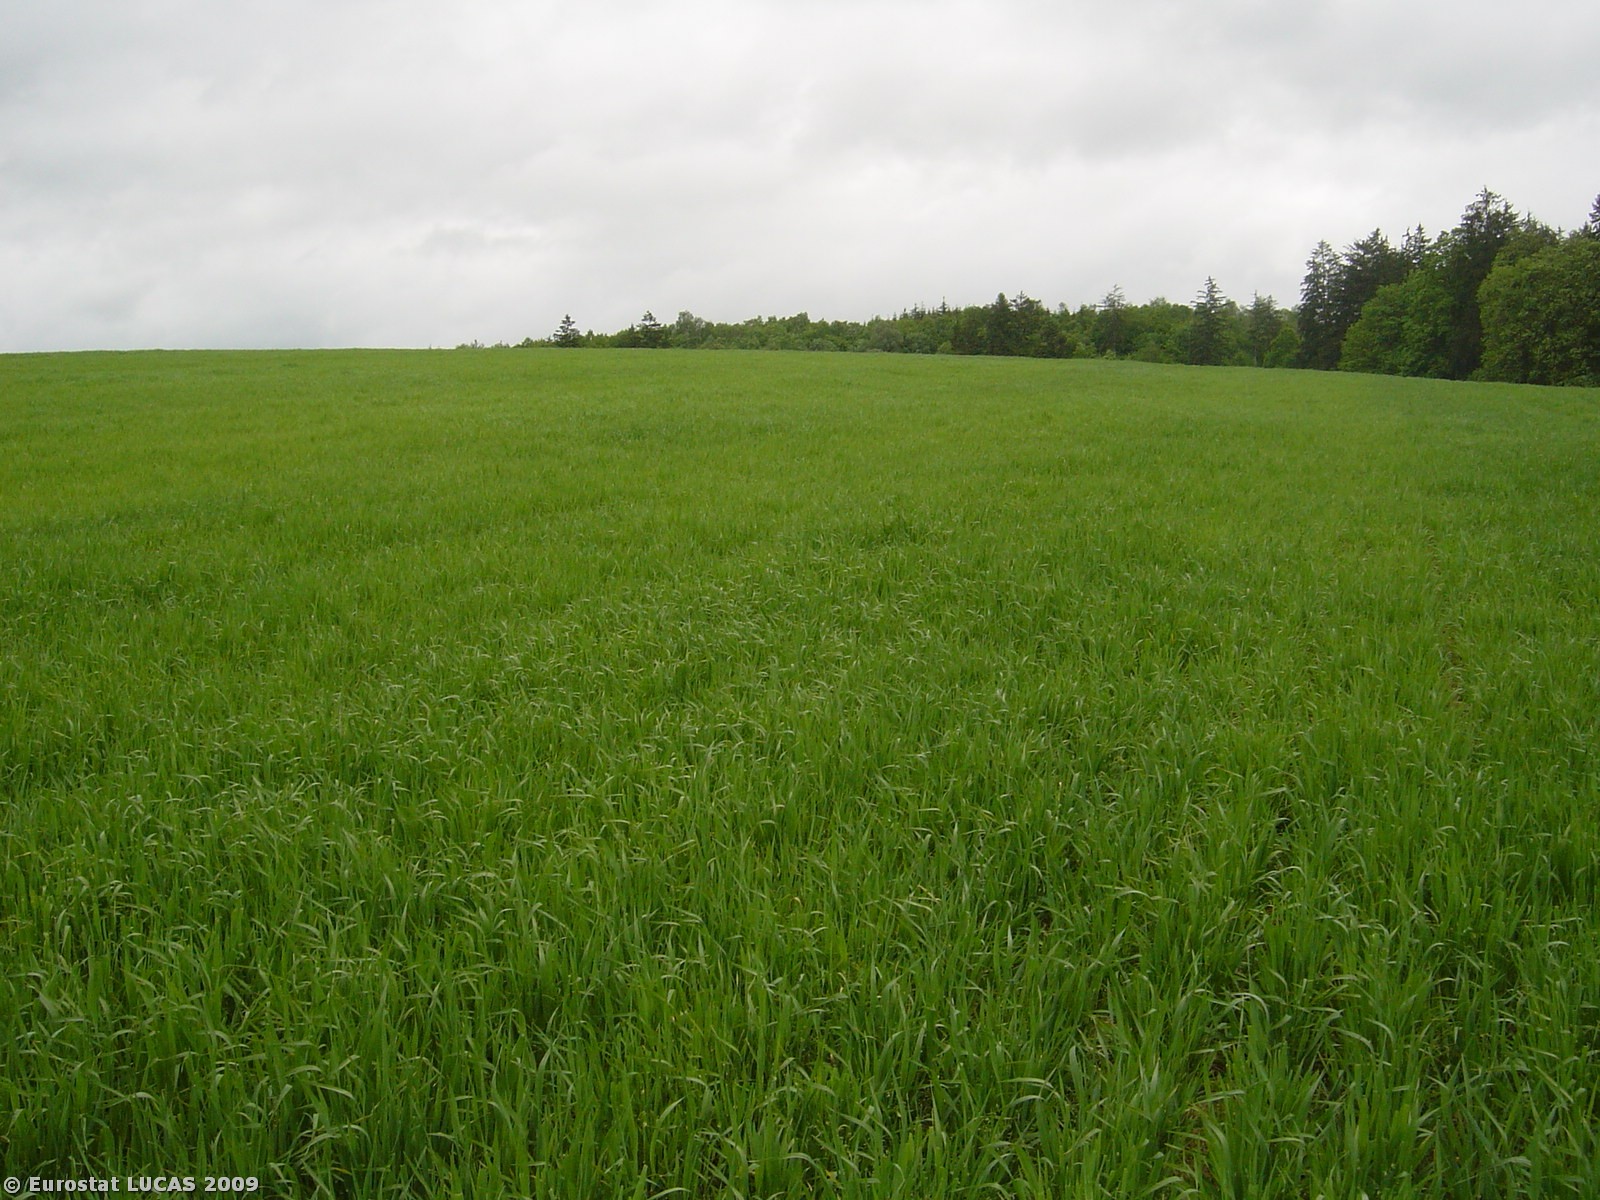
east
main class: Cropland
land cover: Barley
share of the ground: > 75 %
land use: Agriculture (excluding fallow land and kitchen gardens)
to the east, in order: Barley
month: May
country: CZ
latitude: 49.2439
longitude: 16.4490
